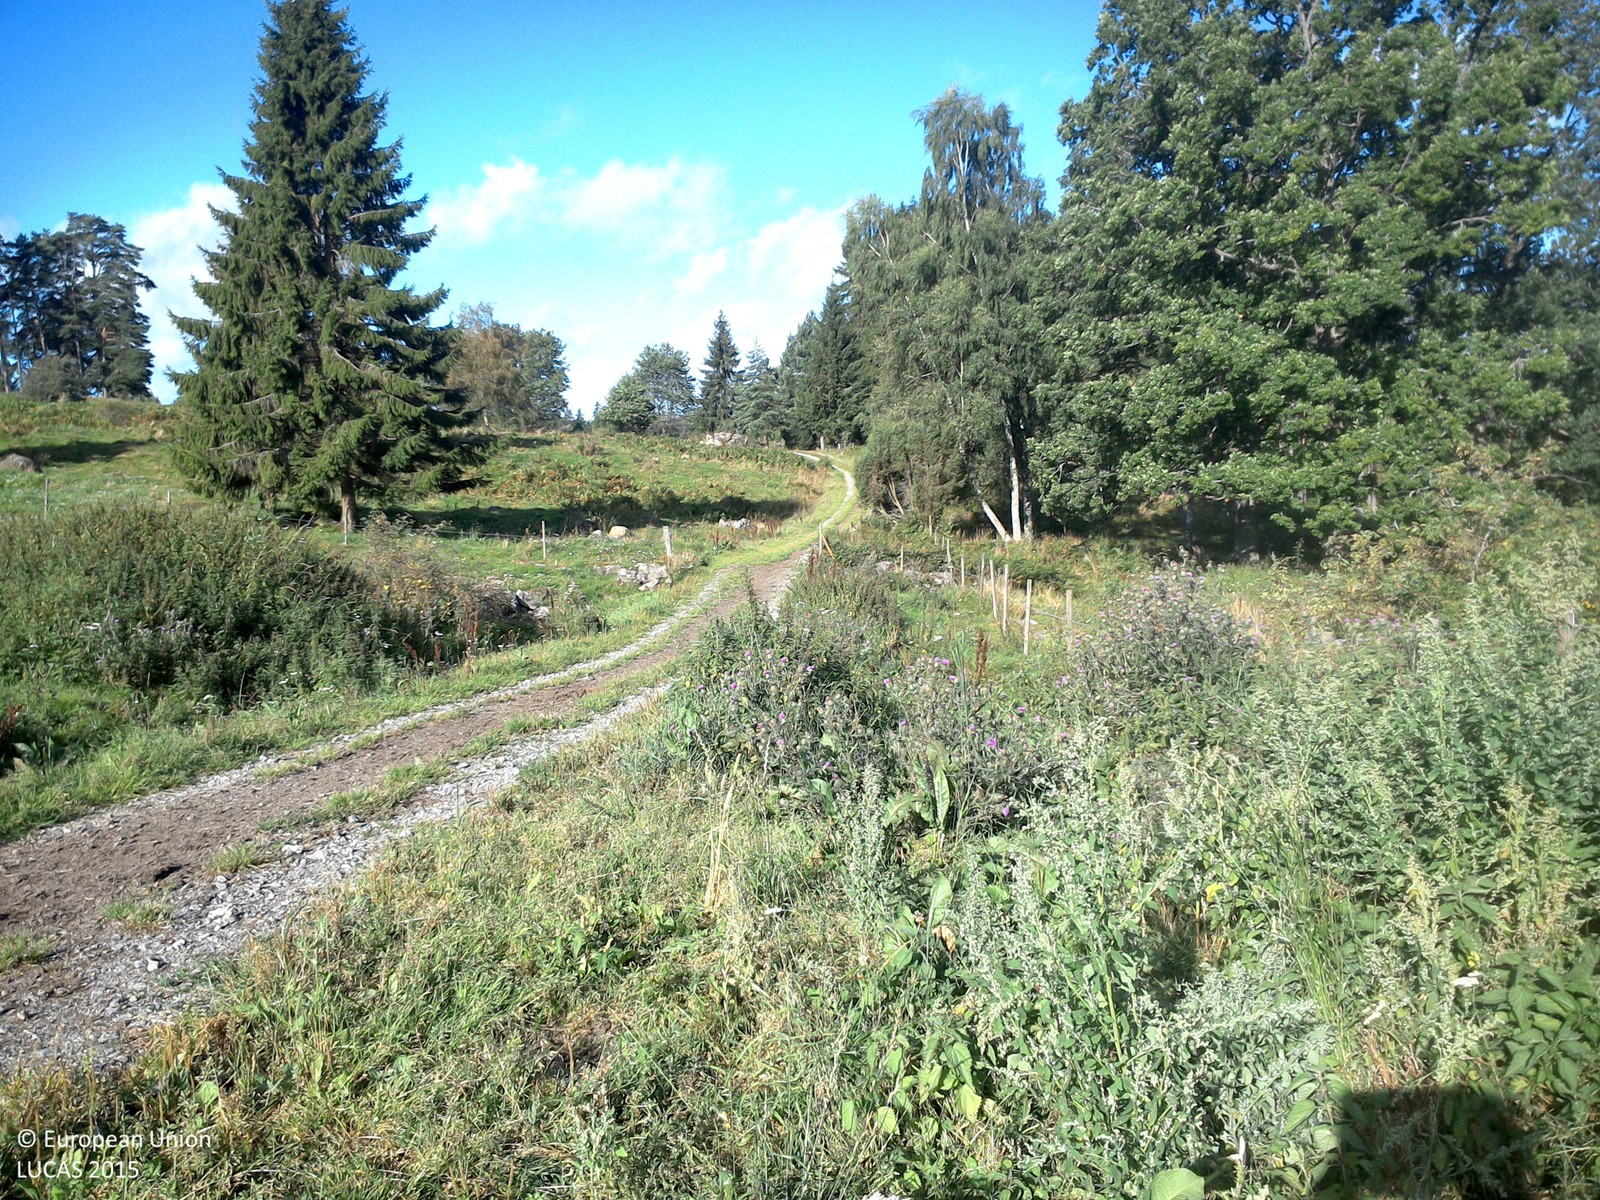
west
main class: Grassland
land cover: Grassland without tree/shrub cover
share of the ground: > 75 %
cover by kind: herbaceous plants 100 %
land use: Agriculture (excluding fallow land and kitchen gardens)
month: August
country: SE
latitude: 57.9176
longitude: 15.2790
